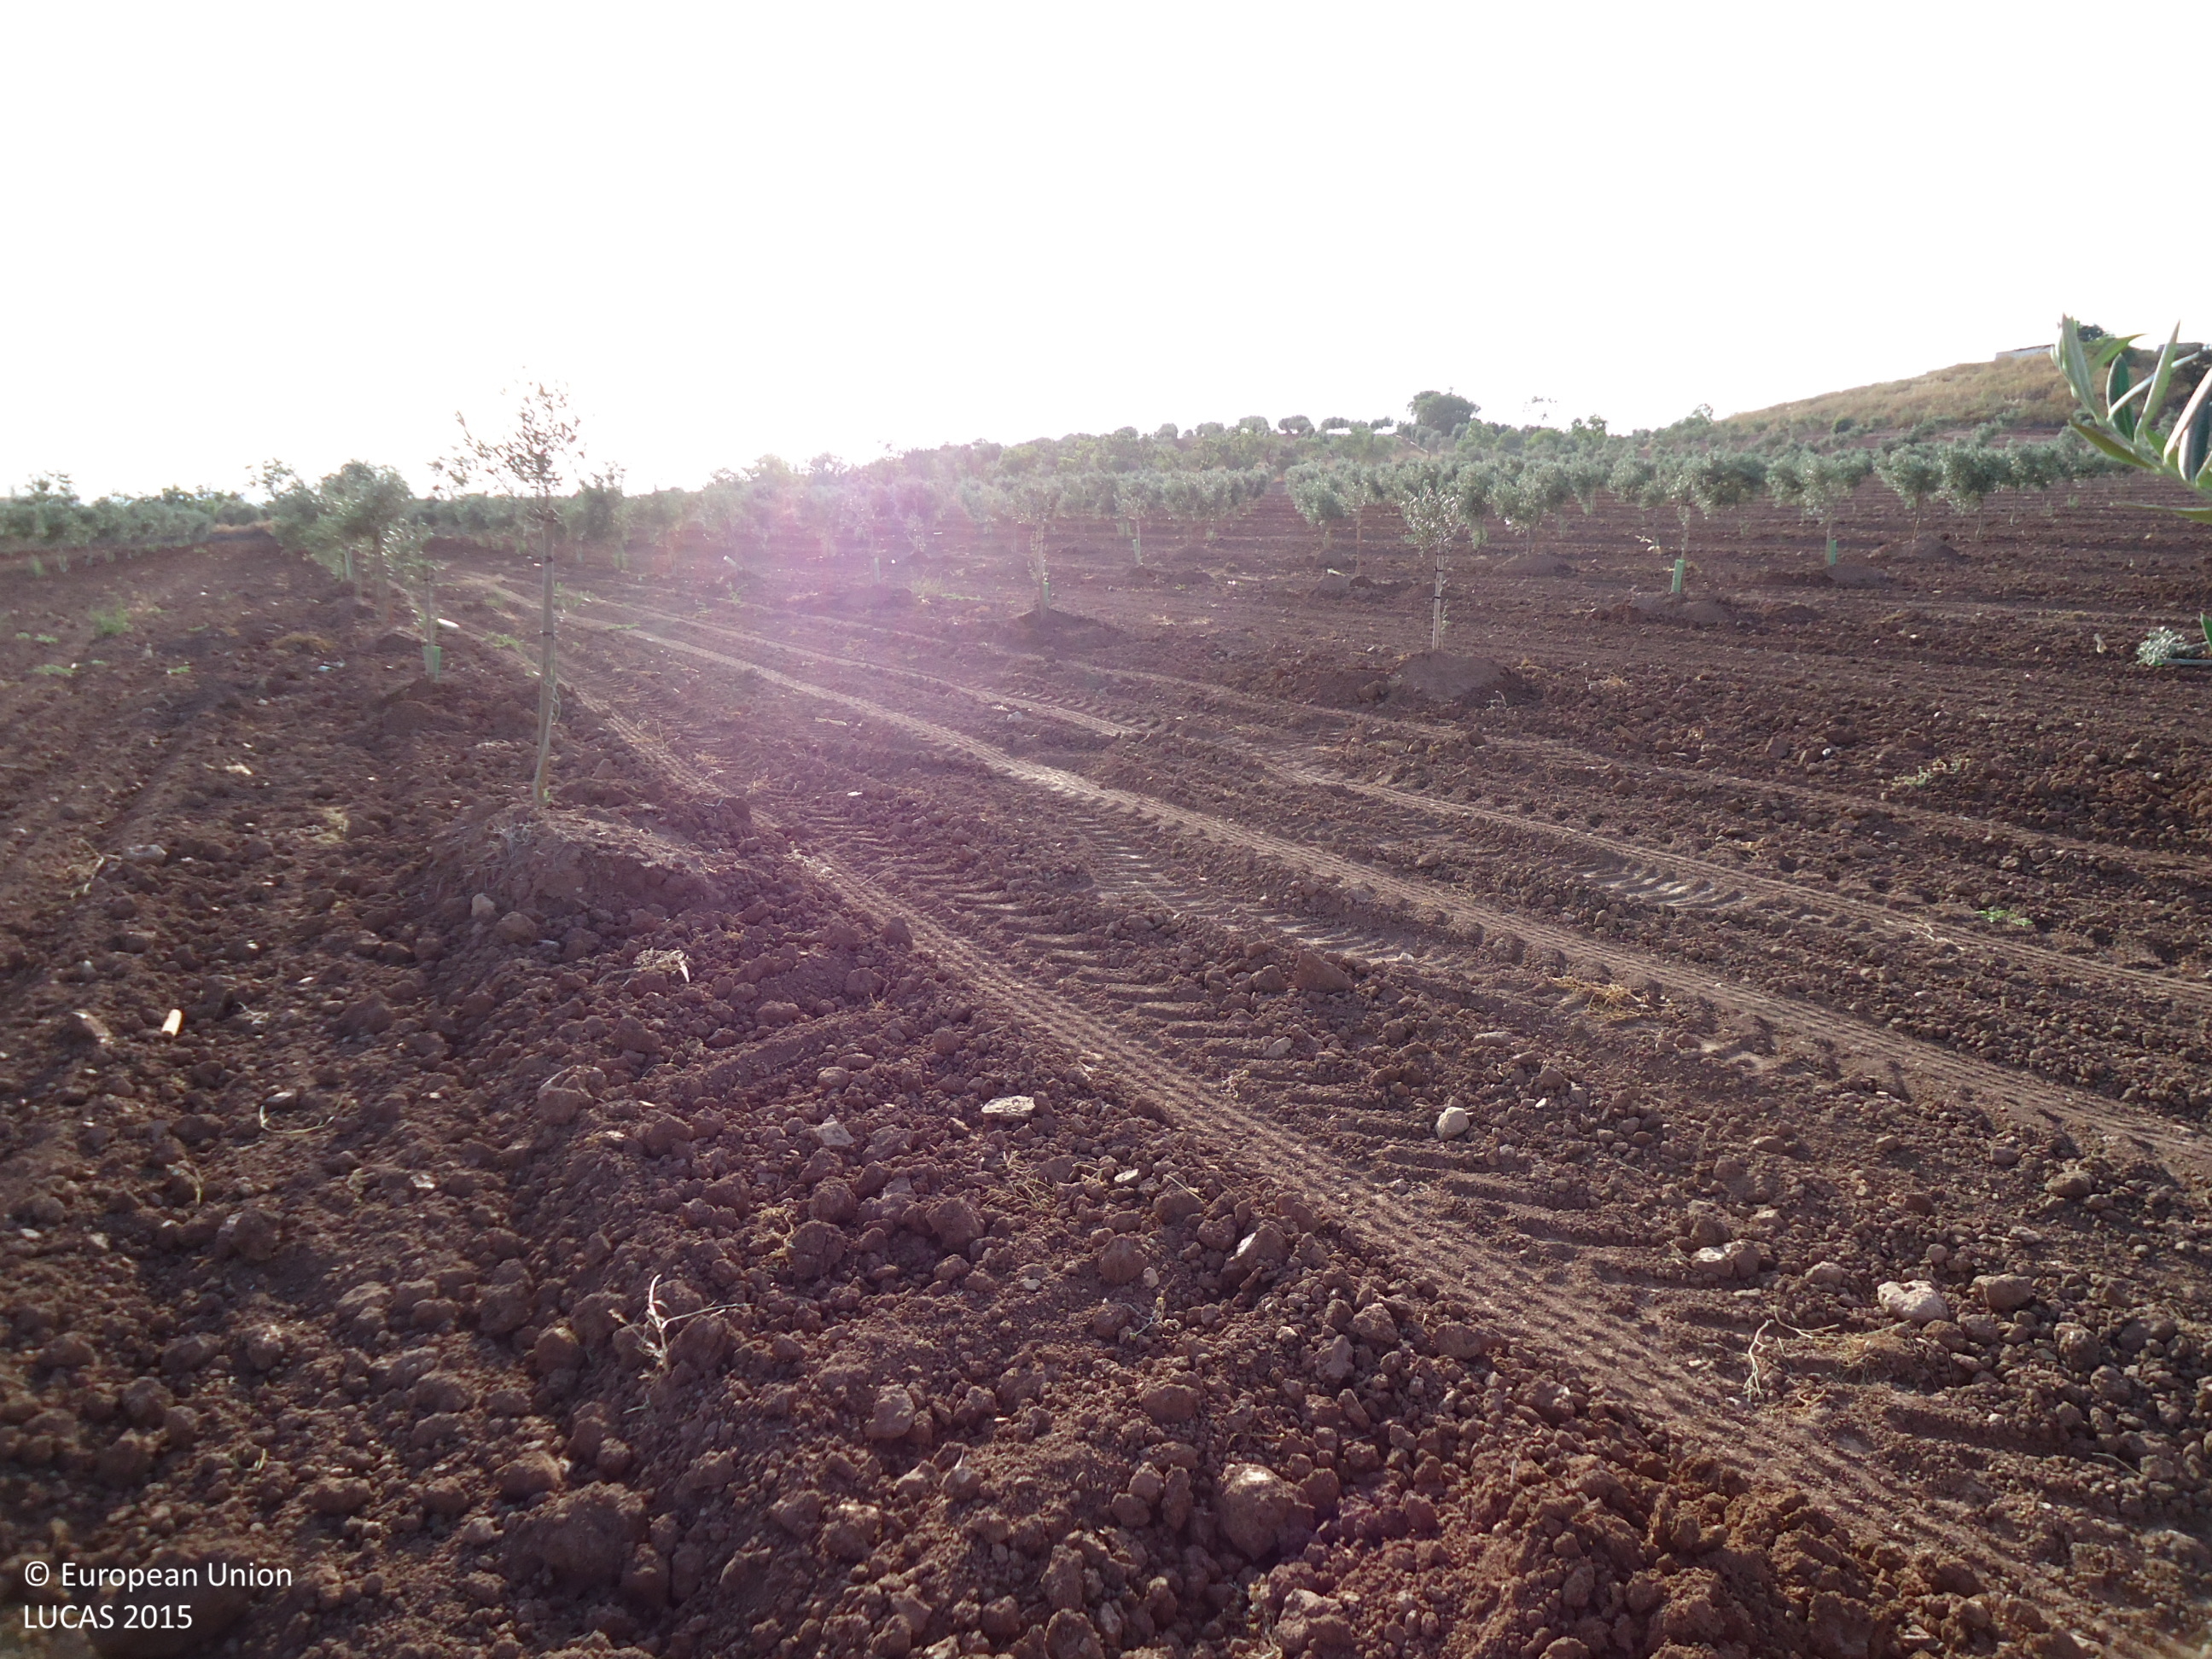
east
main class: Cropland
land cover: Olive groves
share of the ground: 10 - 25 %
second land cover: Other bare soil
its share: > 75 %
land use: Agriculture (excluding fallow land and kitchen gardens)
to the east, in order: Olive groves; Other bare soil; Abandoned hedges; Tracks; Abandoned hedges; Olive groves
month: June
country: ES
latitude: 37.0201
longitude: -4.8255
